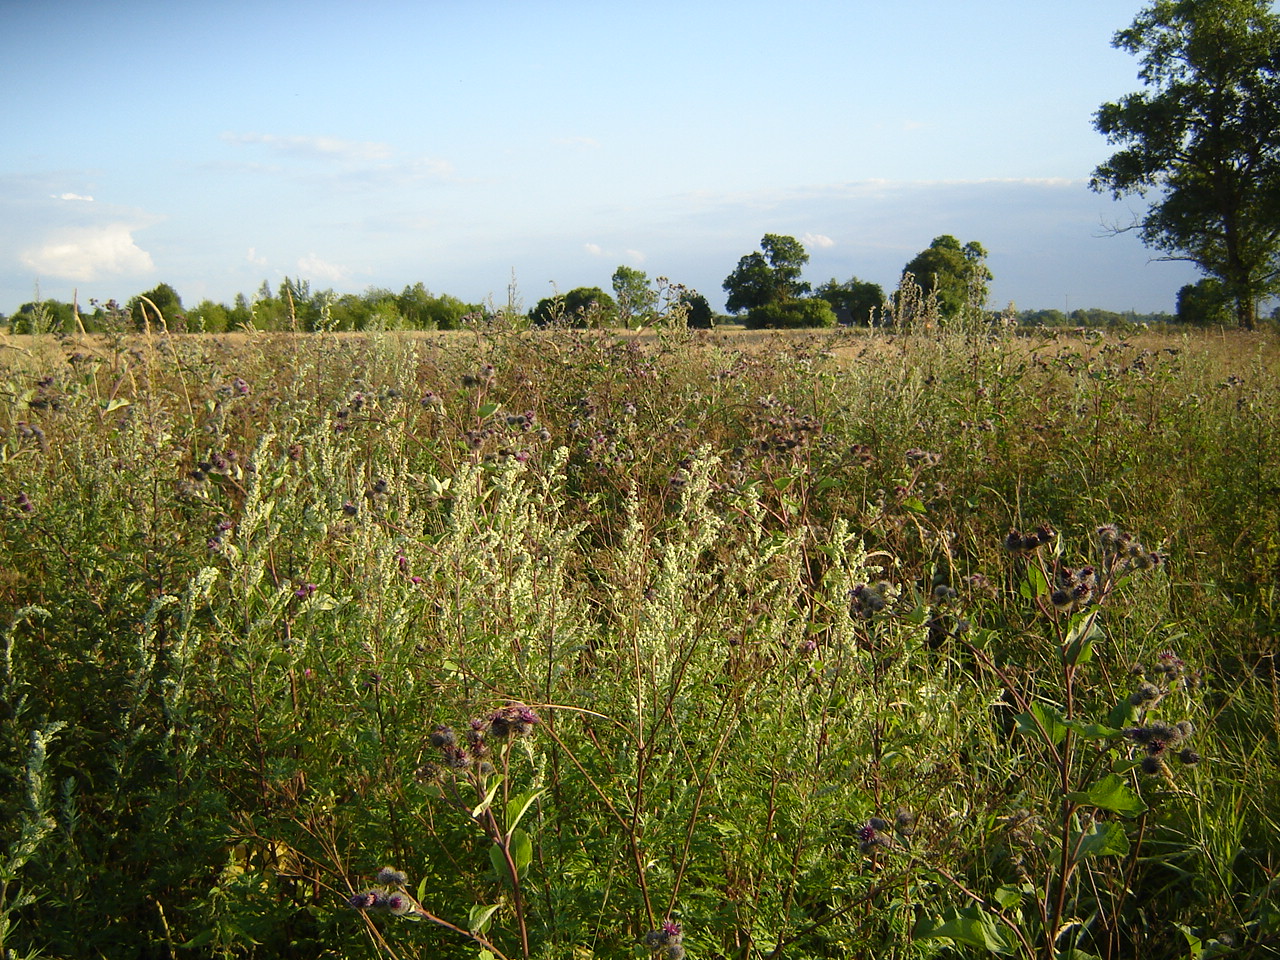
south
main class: Grassland
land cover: Spontaneously vegetated surfaces
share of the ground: > 75 %
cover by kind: herbaceous plants 100 %
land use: Fallow land
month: July
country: LT
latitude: 55.2972
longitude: 24.7055
